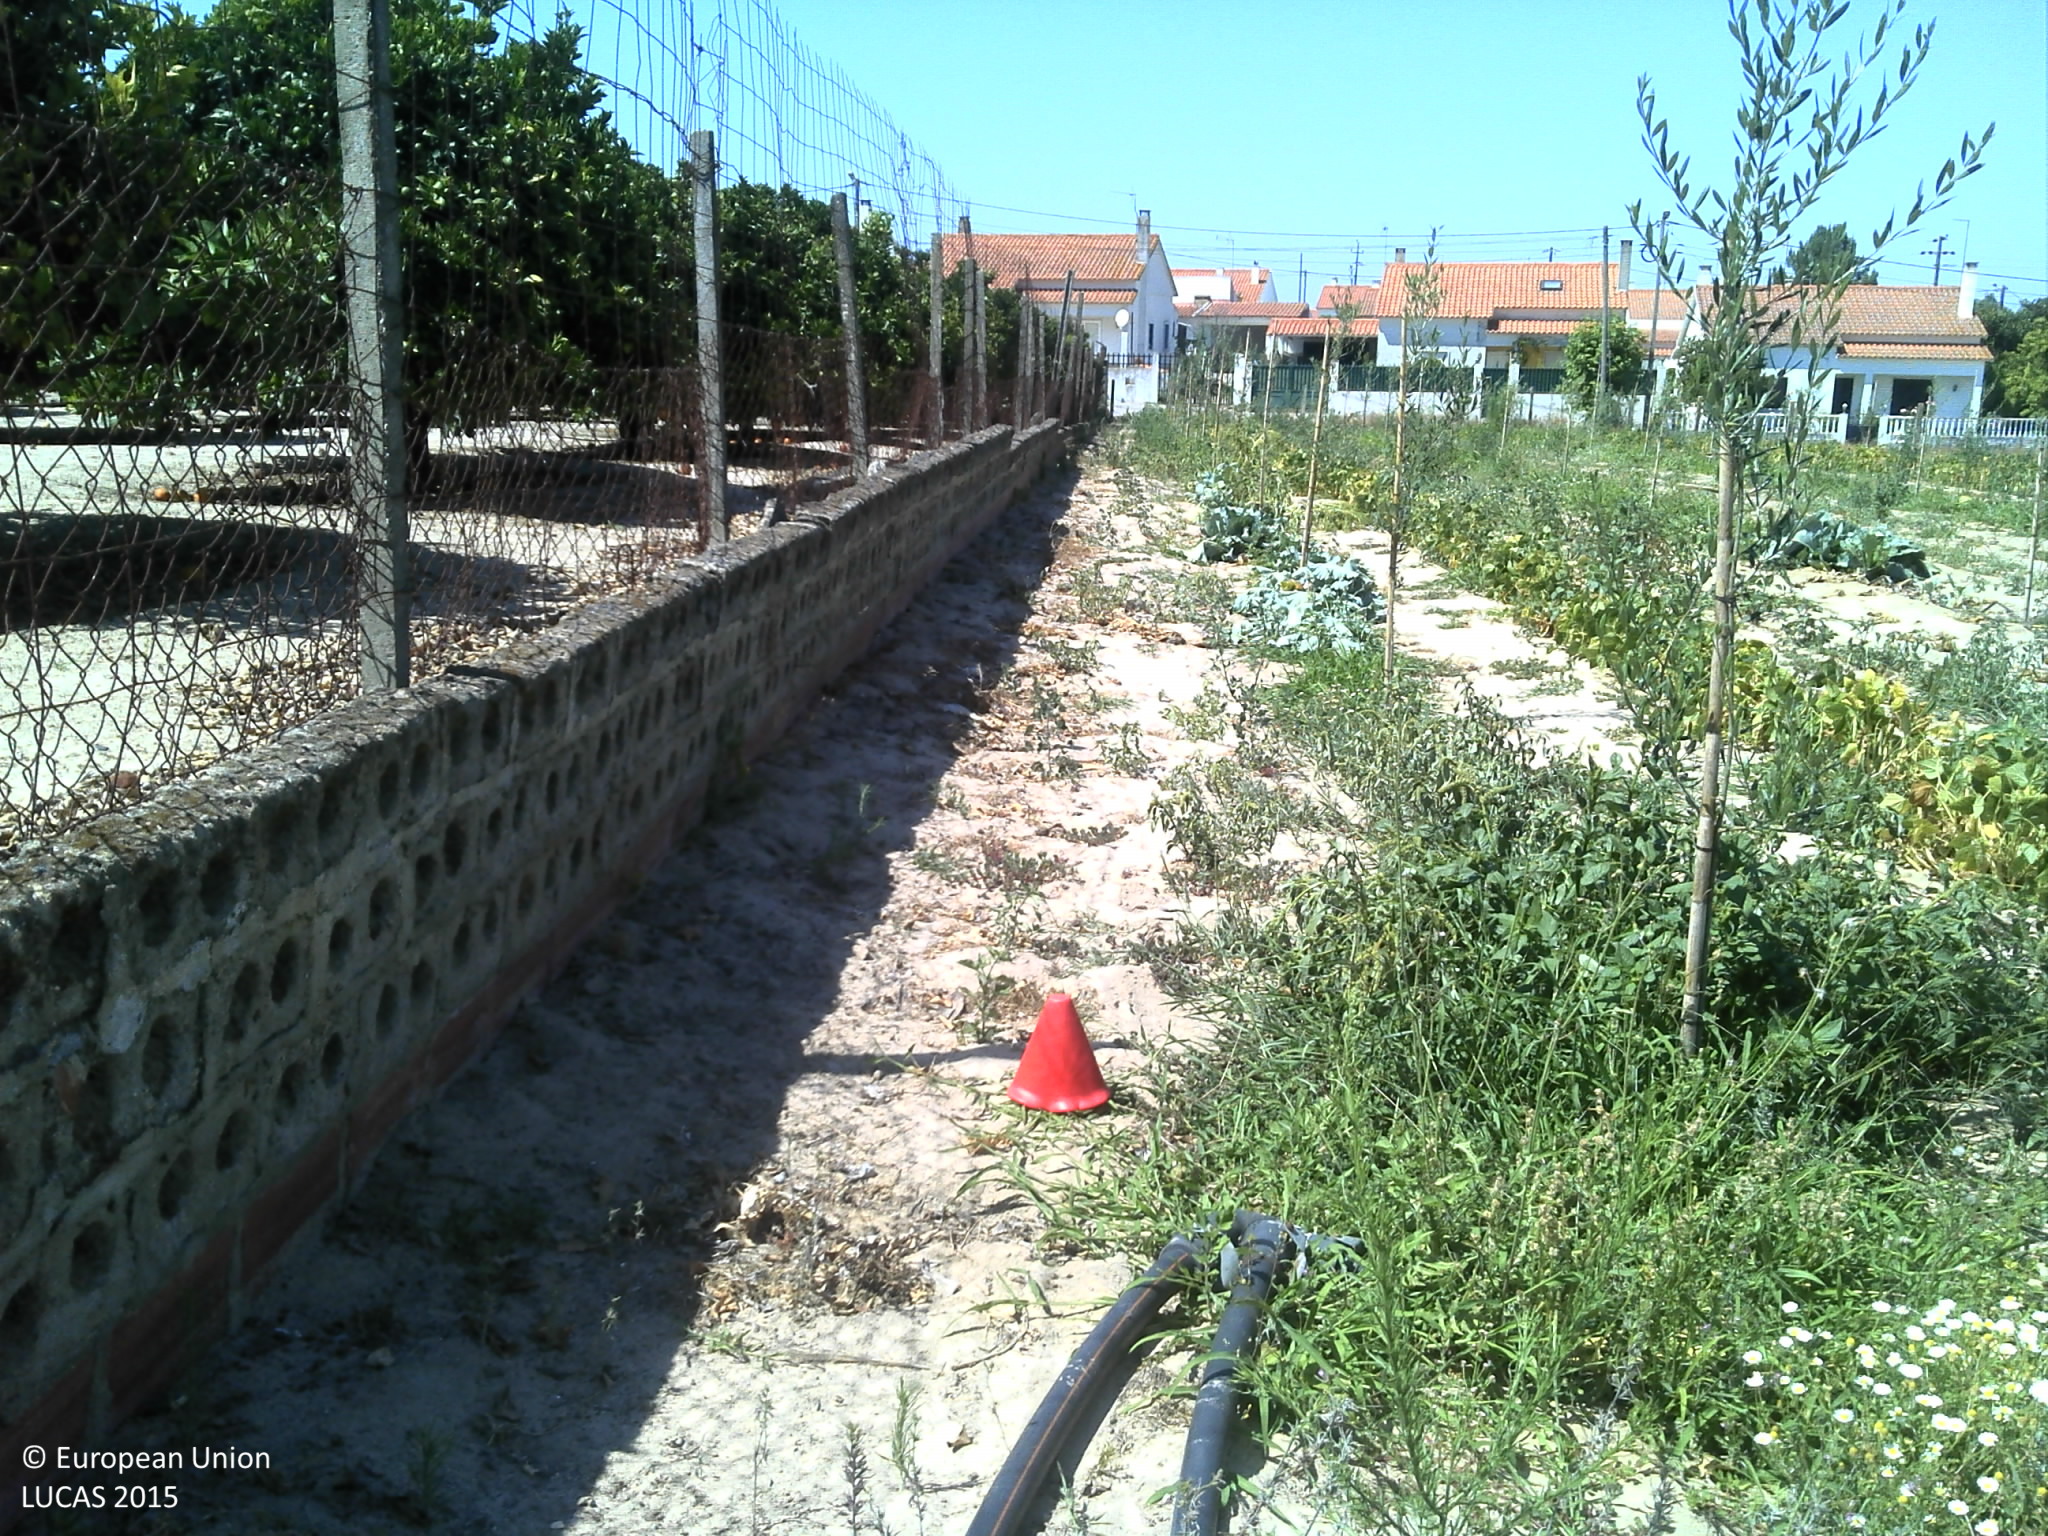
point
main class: Cropland
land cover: Oranges
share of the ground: 50 - 75 %
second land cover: Other bare soil
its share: > 75 %
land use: Agriculture (excluding fallow land and kitchen gardens)
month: June
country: PT
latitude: 39.0470
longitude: -8.6829
